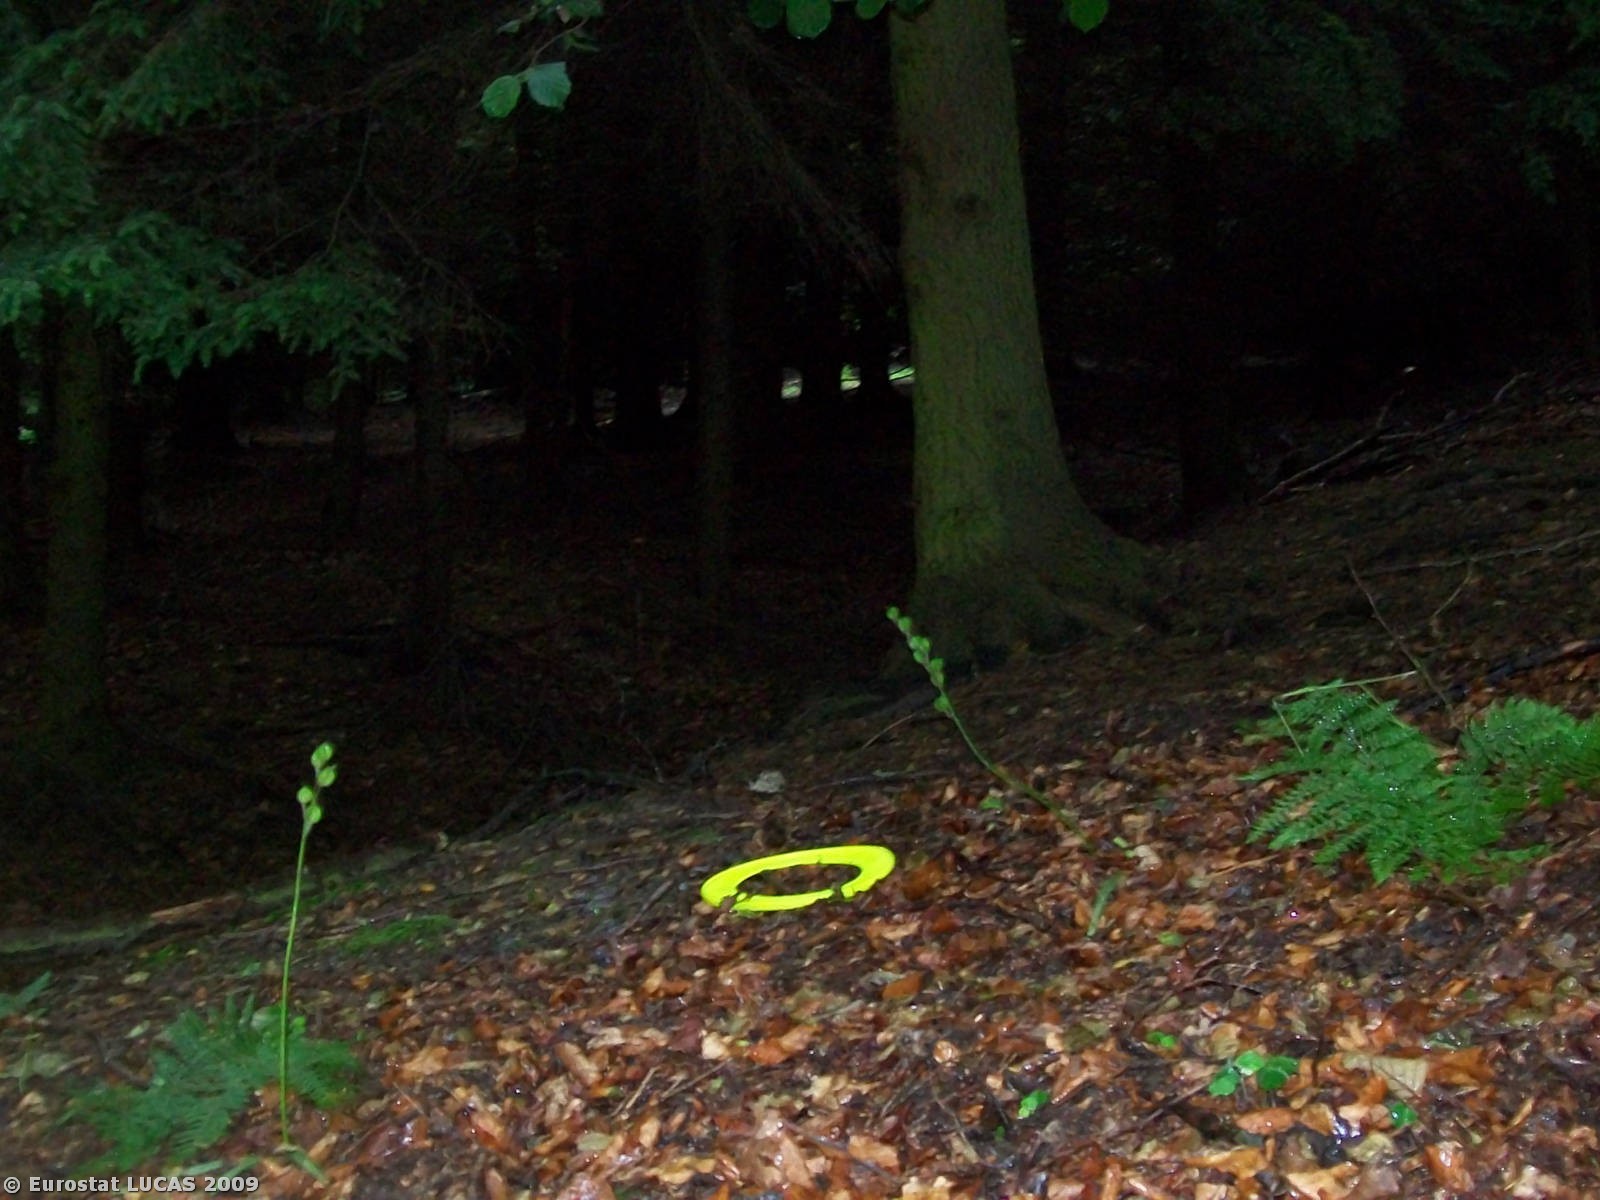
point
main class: Woodland
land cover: Mixed woodland
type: plantations and self-sown exotic forest
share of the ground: 10 - 25 %
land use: Forestry
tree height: > 5 m
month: July
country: GB
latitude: 54.3338
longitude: -1.1944
